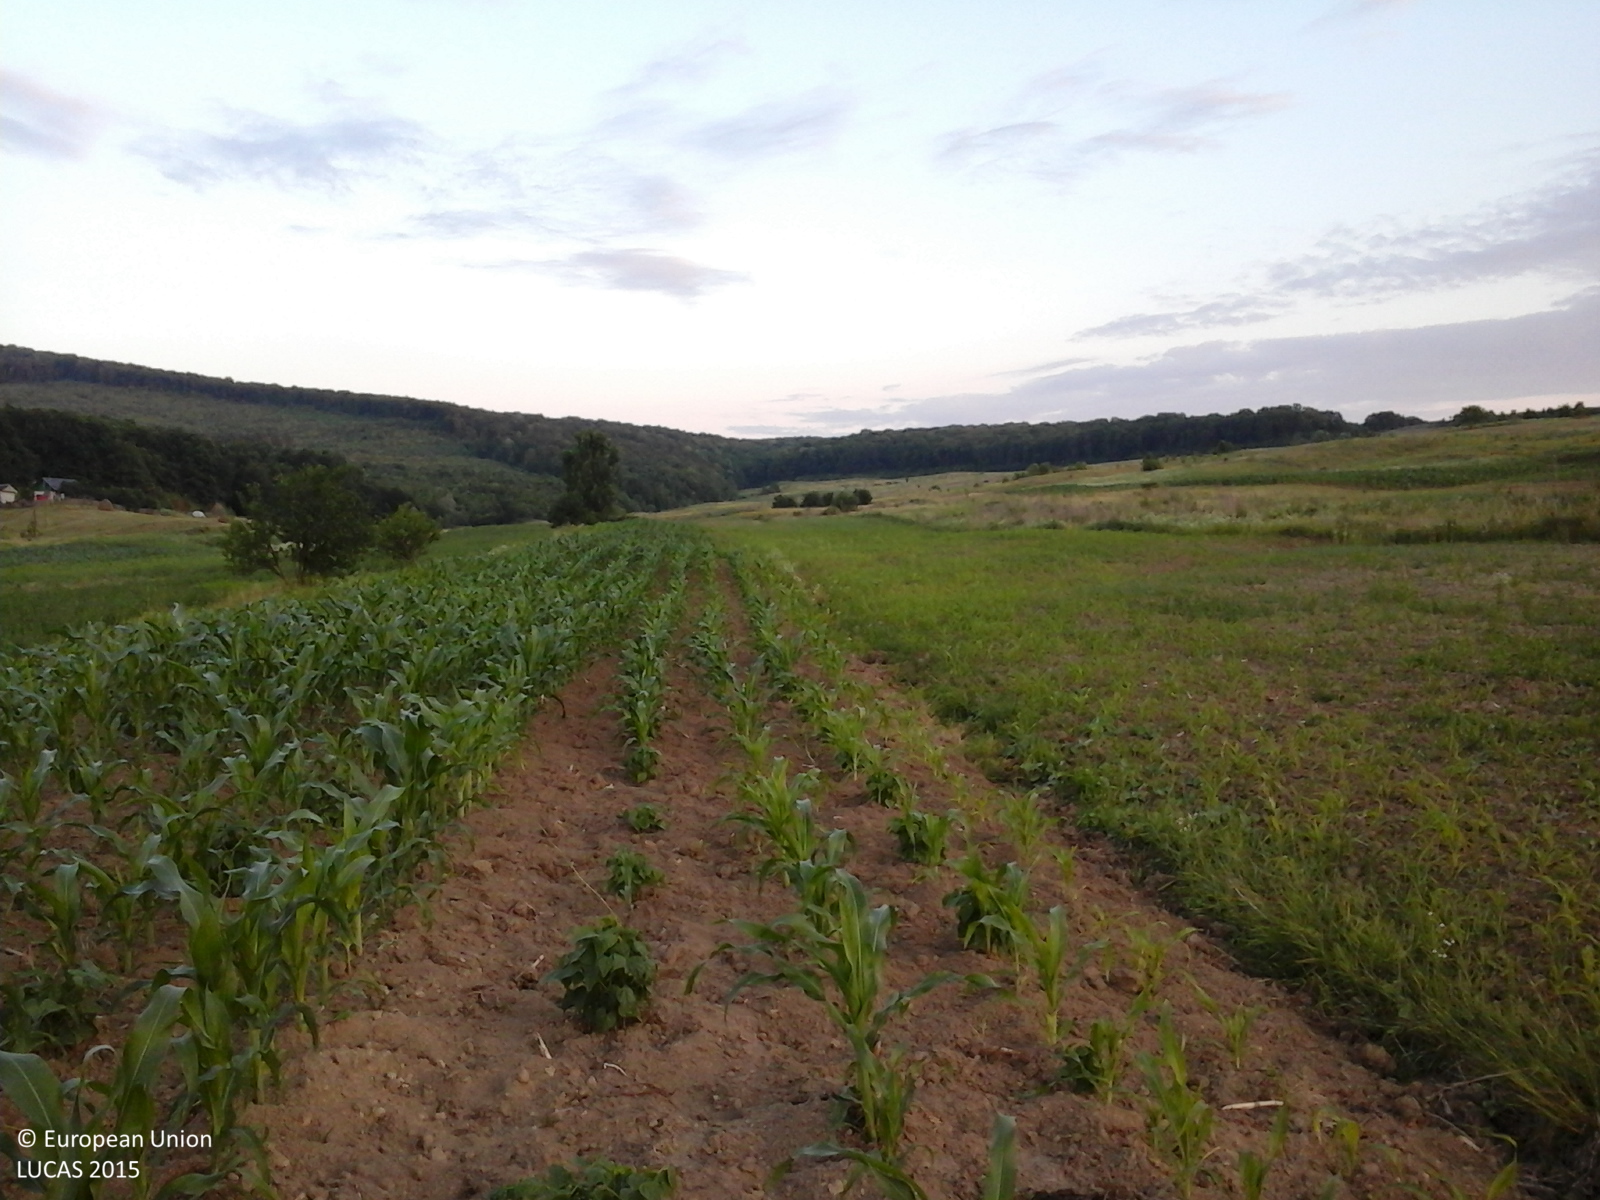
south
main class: Cropland
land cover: Maize
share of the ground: 25 - 50 %
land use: Agriculture (excluding fallow land and kitchen gardens)
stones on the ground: < 10 %
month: June
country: RO
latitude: 47.6033
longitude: 26.7908
